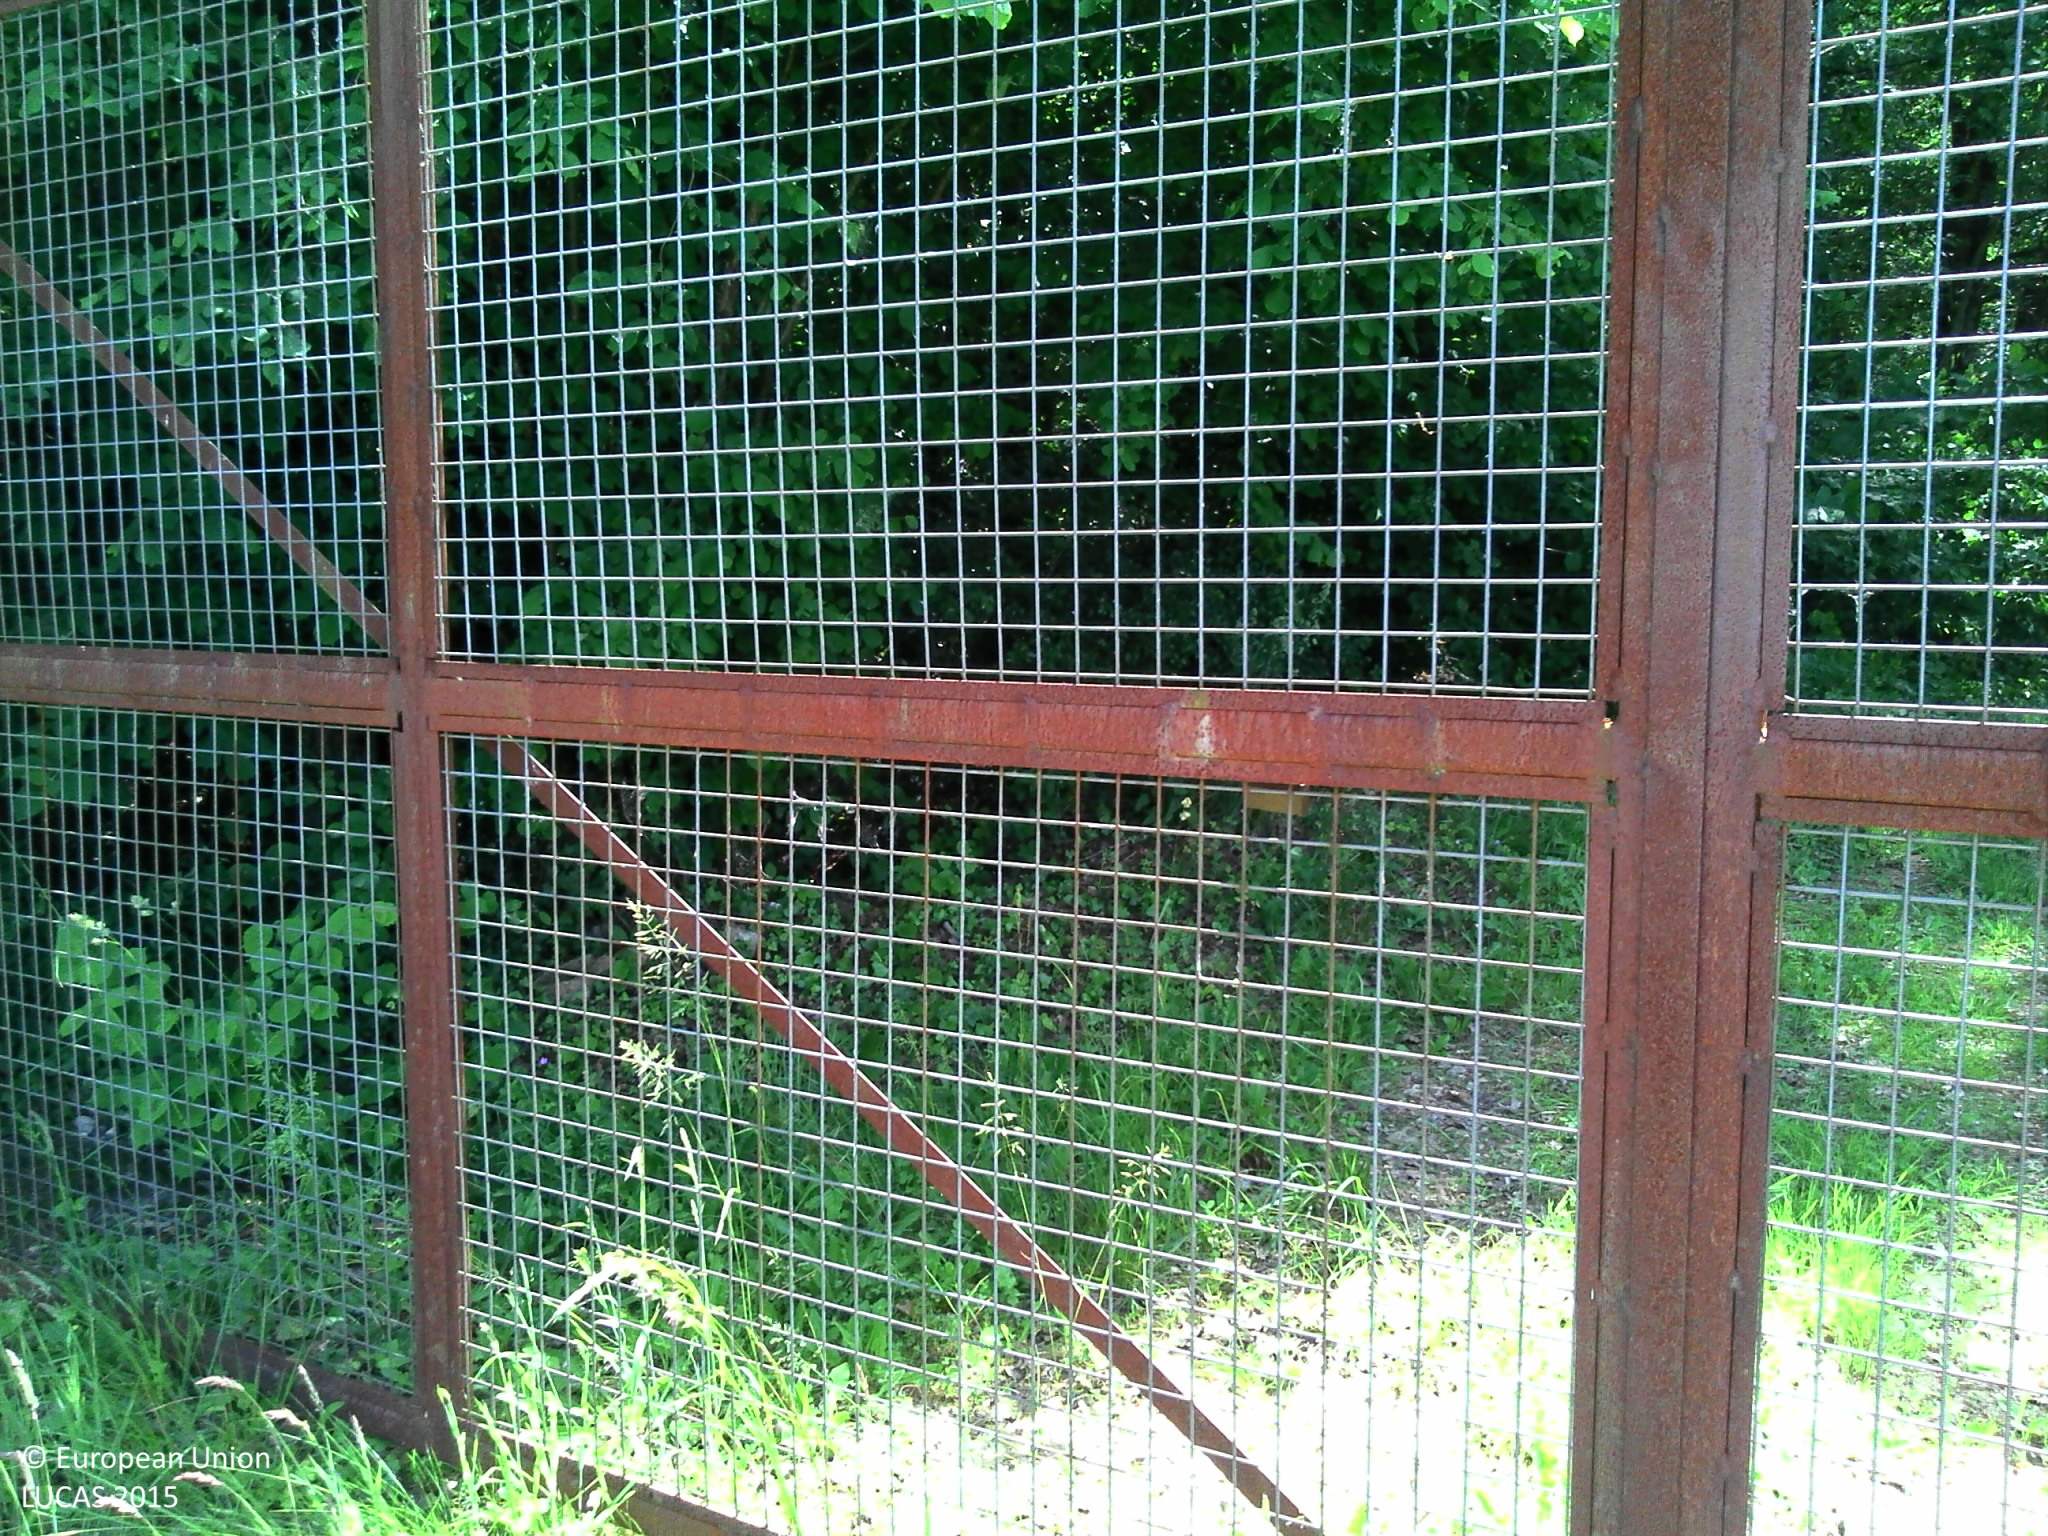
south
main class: Woodland
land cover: Broadleaved woodland
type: mesophytic deciduous forest
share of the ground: > 75 %
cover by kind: broadleaved forest trees 85 %, shrubs 10 %, herbaceous plants 5 %
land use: Forestry
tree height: > 5 m
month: June
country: FR
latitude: 46.9997
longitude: 0.1271
